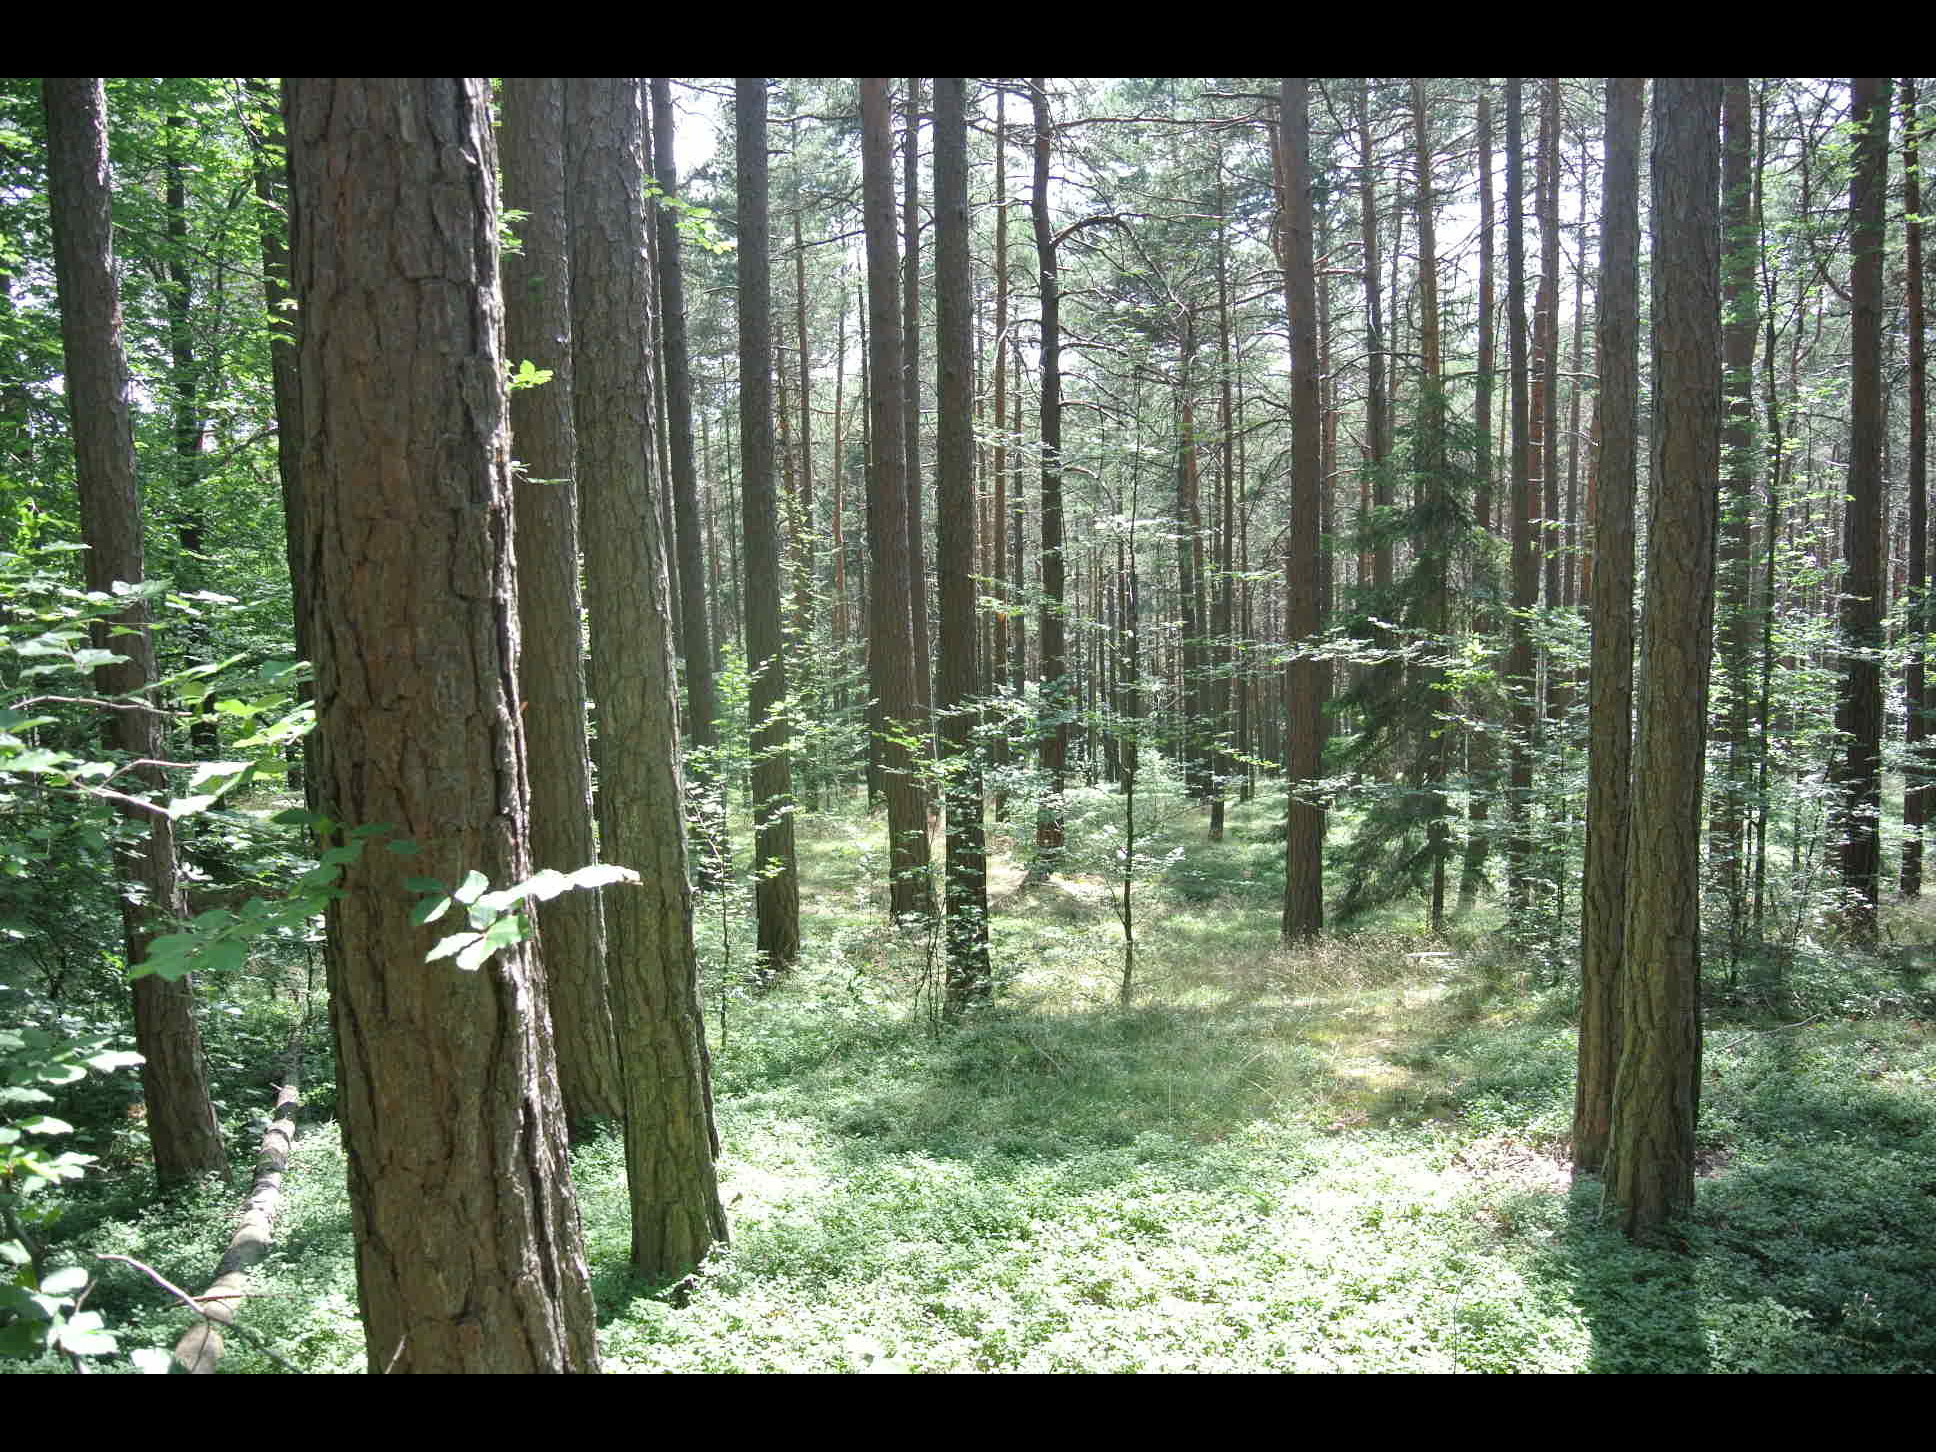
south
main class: Woodland
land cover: Pine dominated coniferous woodland
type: alpine coniferous forest
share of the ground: > 75 %
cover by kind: coniferous forest trees 85 %, broadleaved forest trees 10 %, lichens and mosses 5 %
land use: Forestry
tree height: > 5 m
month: July
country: AT
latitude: 47.6045
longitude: 16.0815
